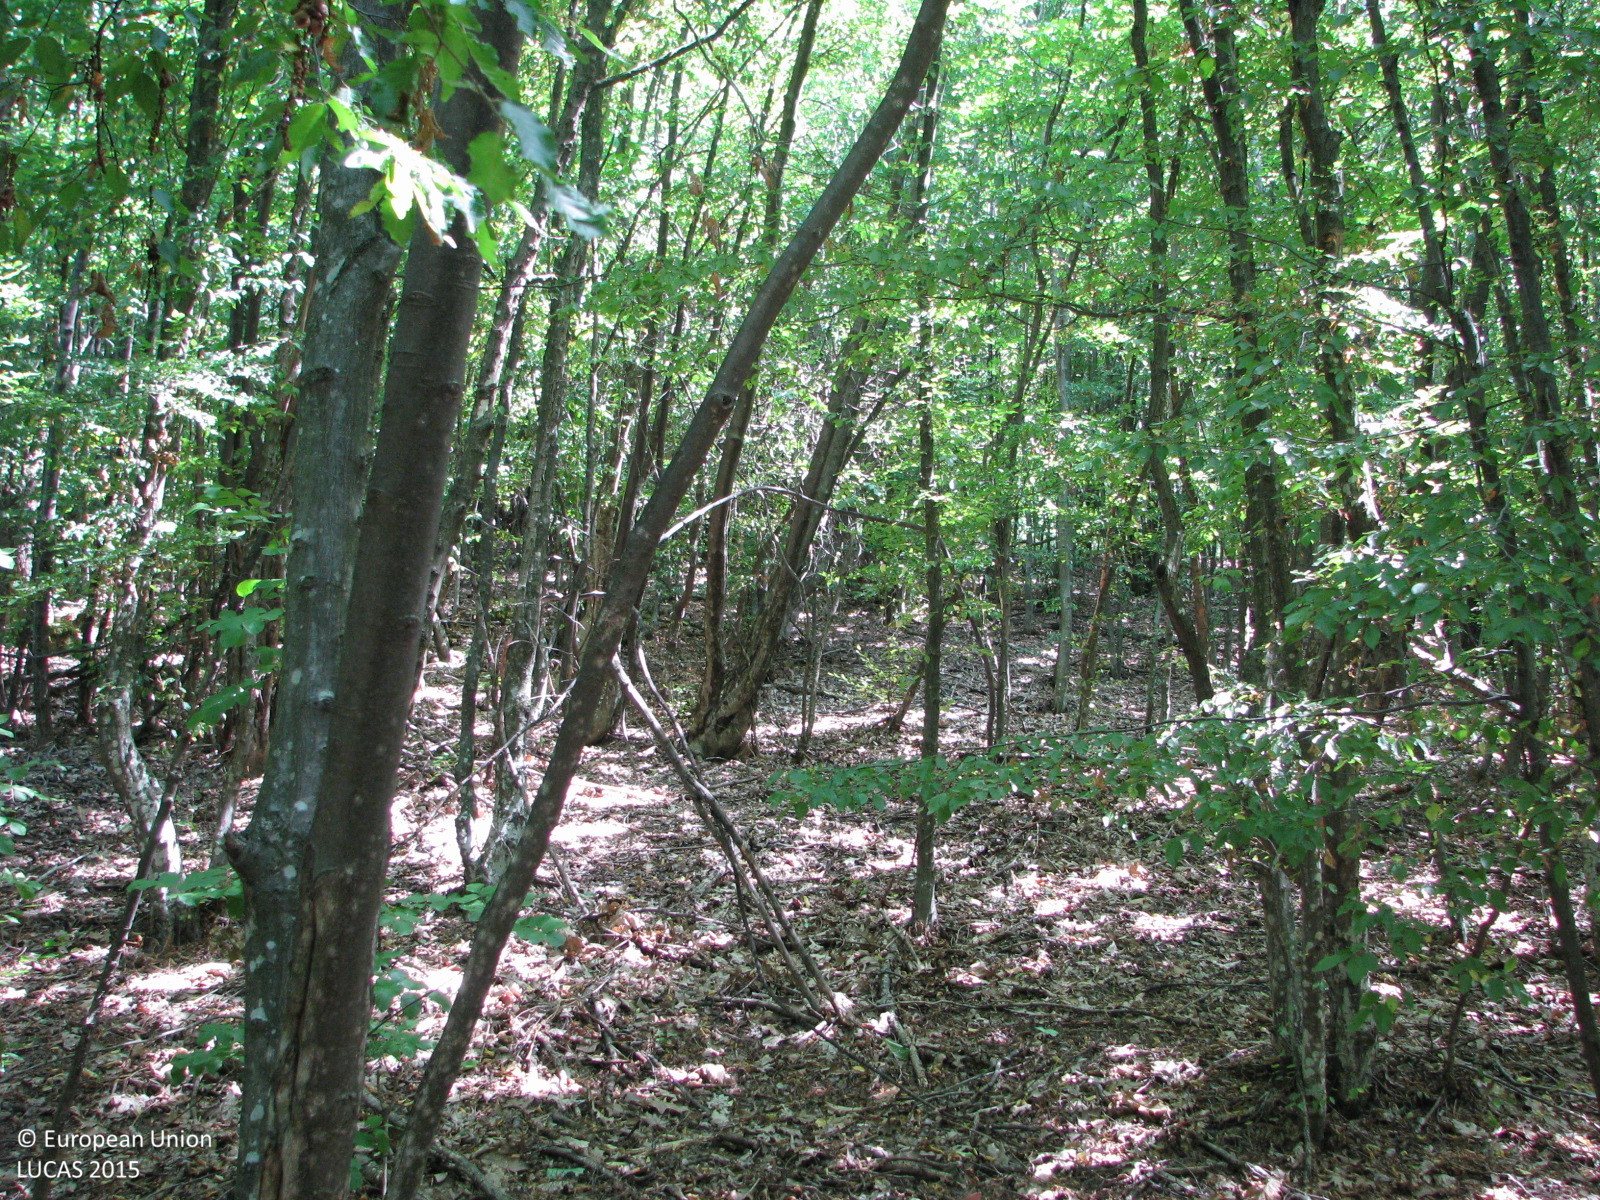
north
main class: Woodland
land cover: Broadleaved woodland
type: beech forest
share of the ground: > 75 %
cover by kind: broadleaved forest trees 85 %, unconsolidated bare surface 15 %
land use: Forestry
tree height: > 5 m
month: August
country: BG
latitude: 42.7582
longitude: 26.1804
